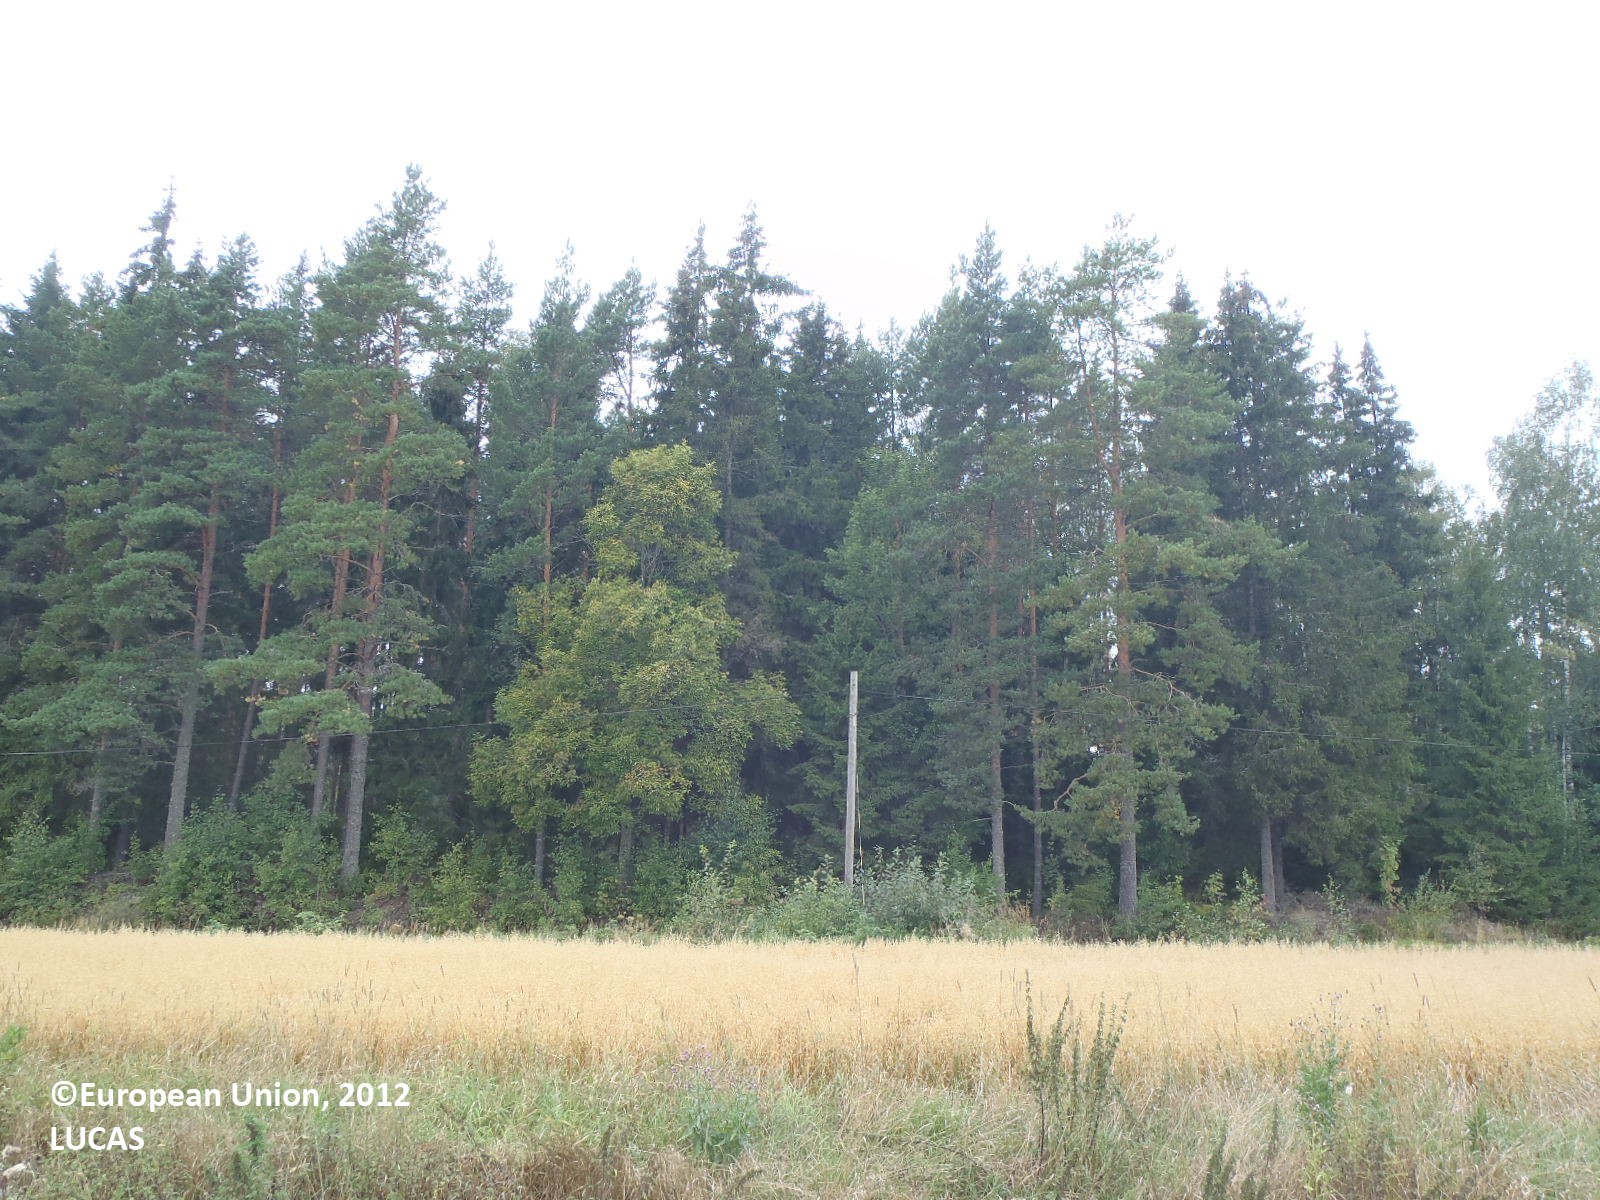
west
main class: Cropland
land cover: Oats
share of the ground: > 75 %
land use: Agriculture (excluding fallow land and kitchen gardens)
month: August
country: FI
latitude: 60.7631
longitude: 21.9731
